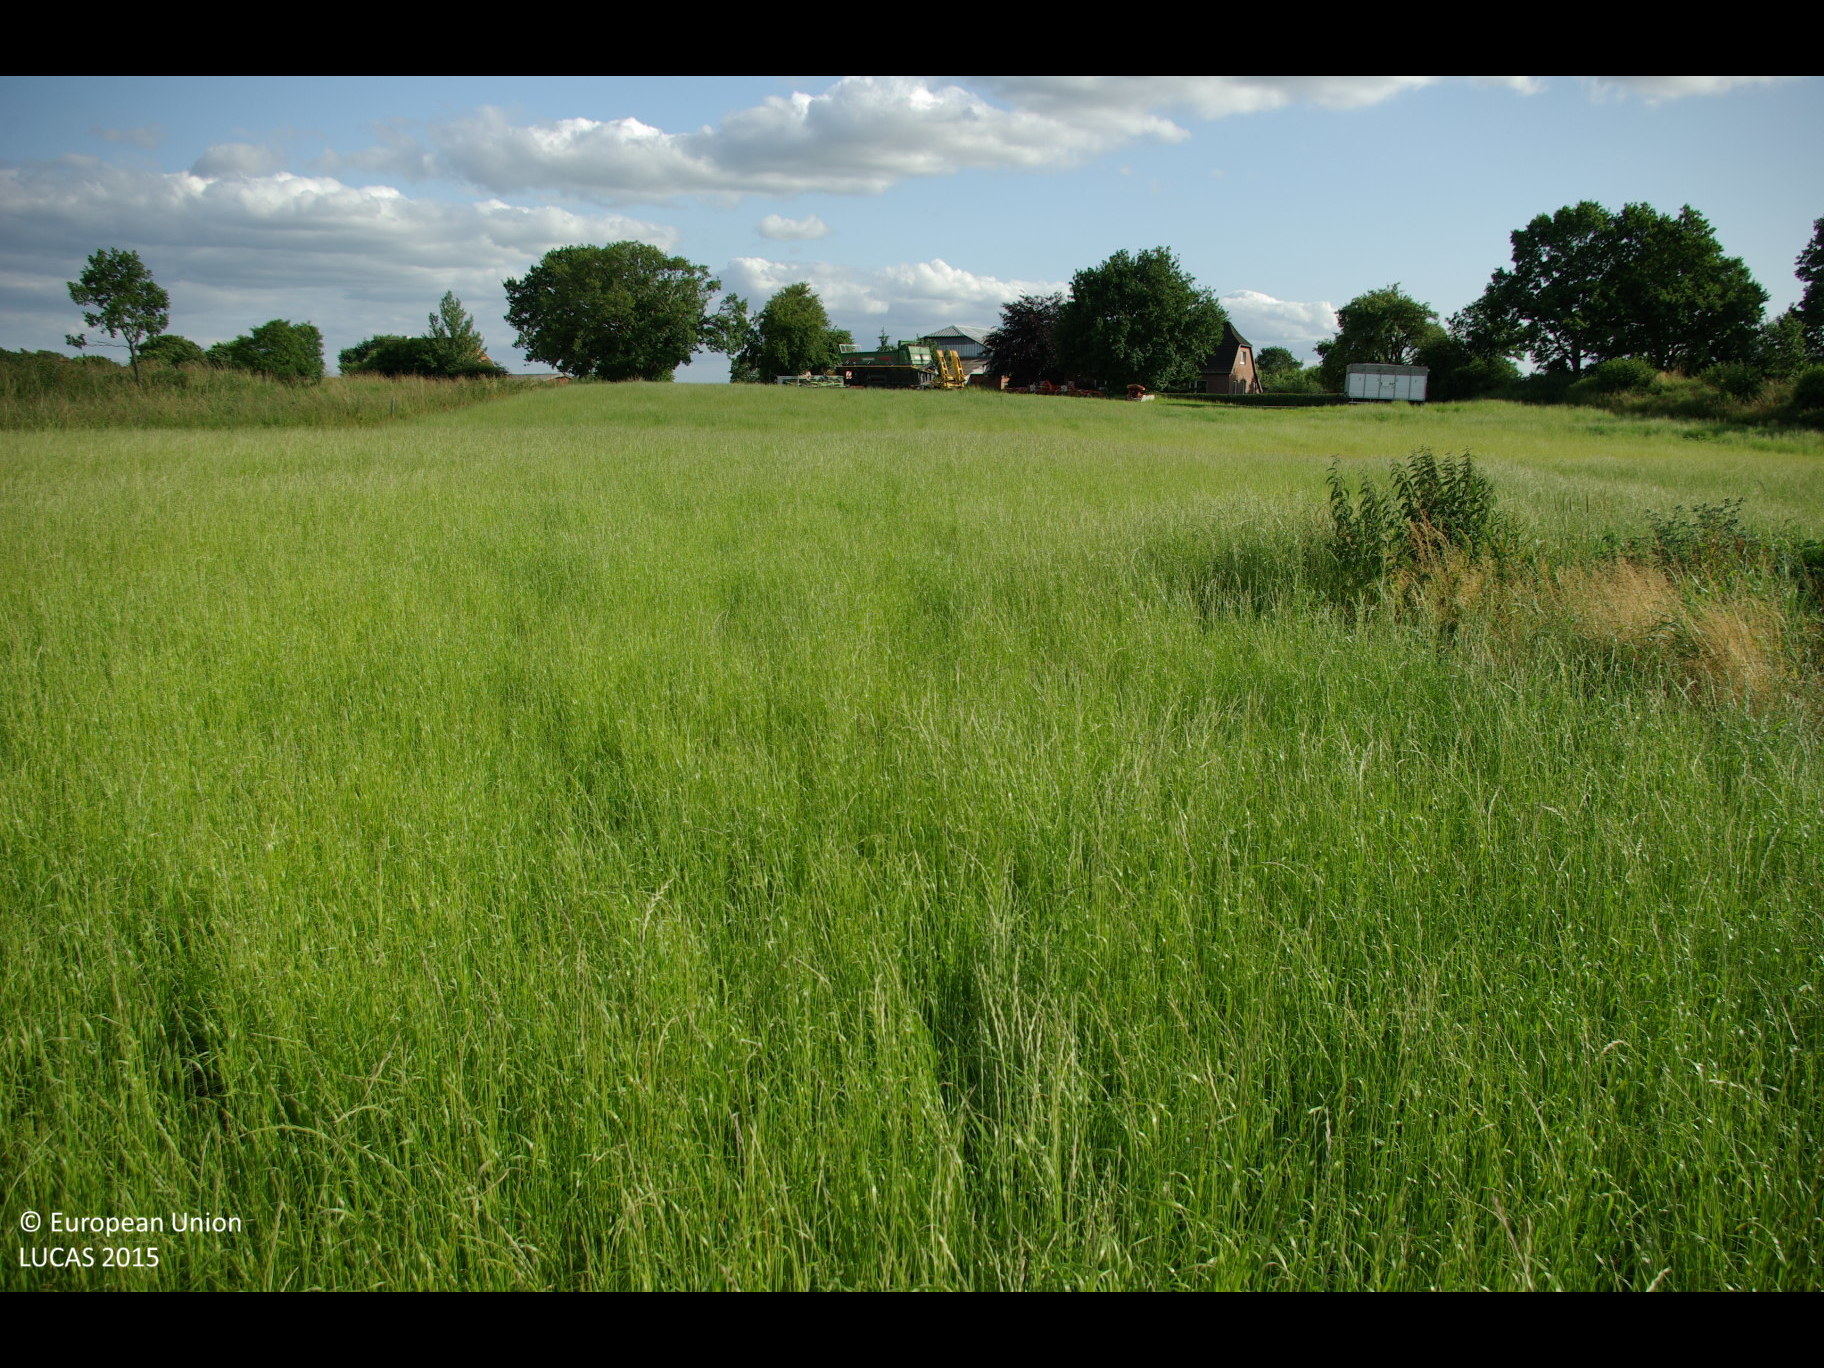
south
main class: Grassland
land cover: Grassland without tree/shrub cover
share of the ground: > 75 %
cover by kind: herbaceous plants 100 %
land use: Agriculture (excluding fallow land and kitchen gardens)
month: July
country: DE
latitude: 54.7850
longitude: 9.5494
